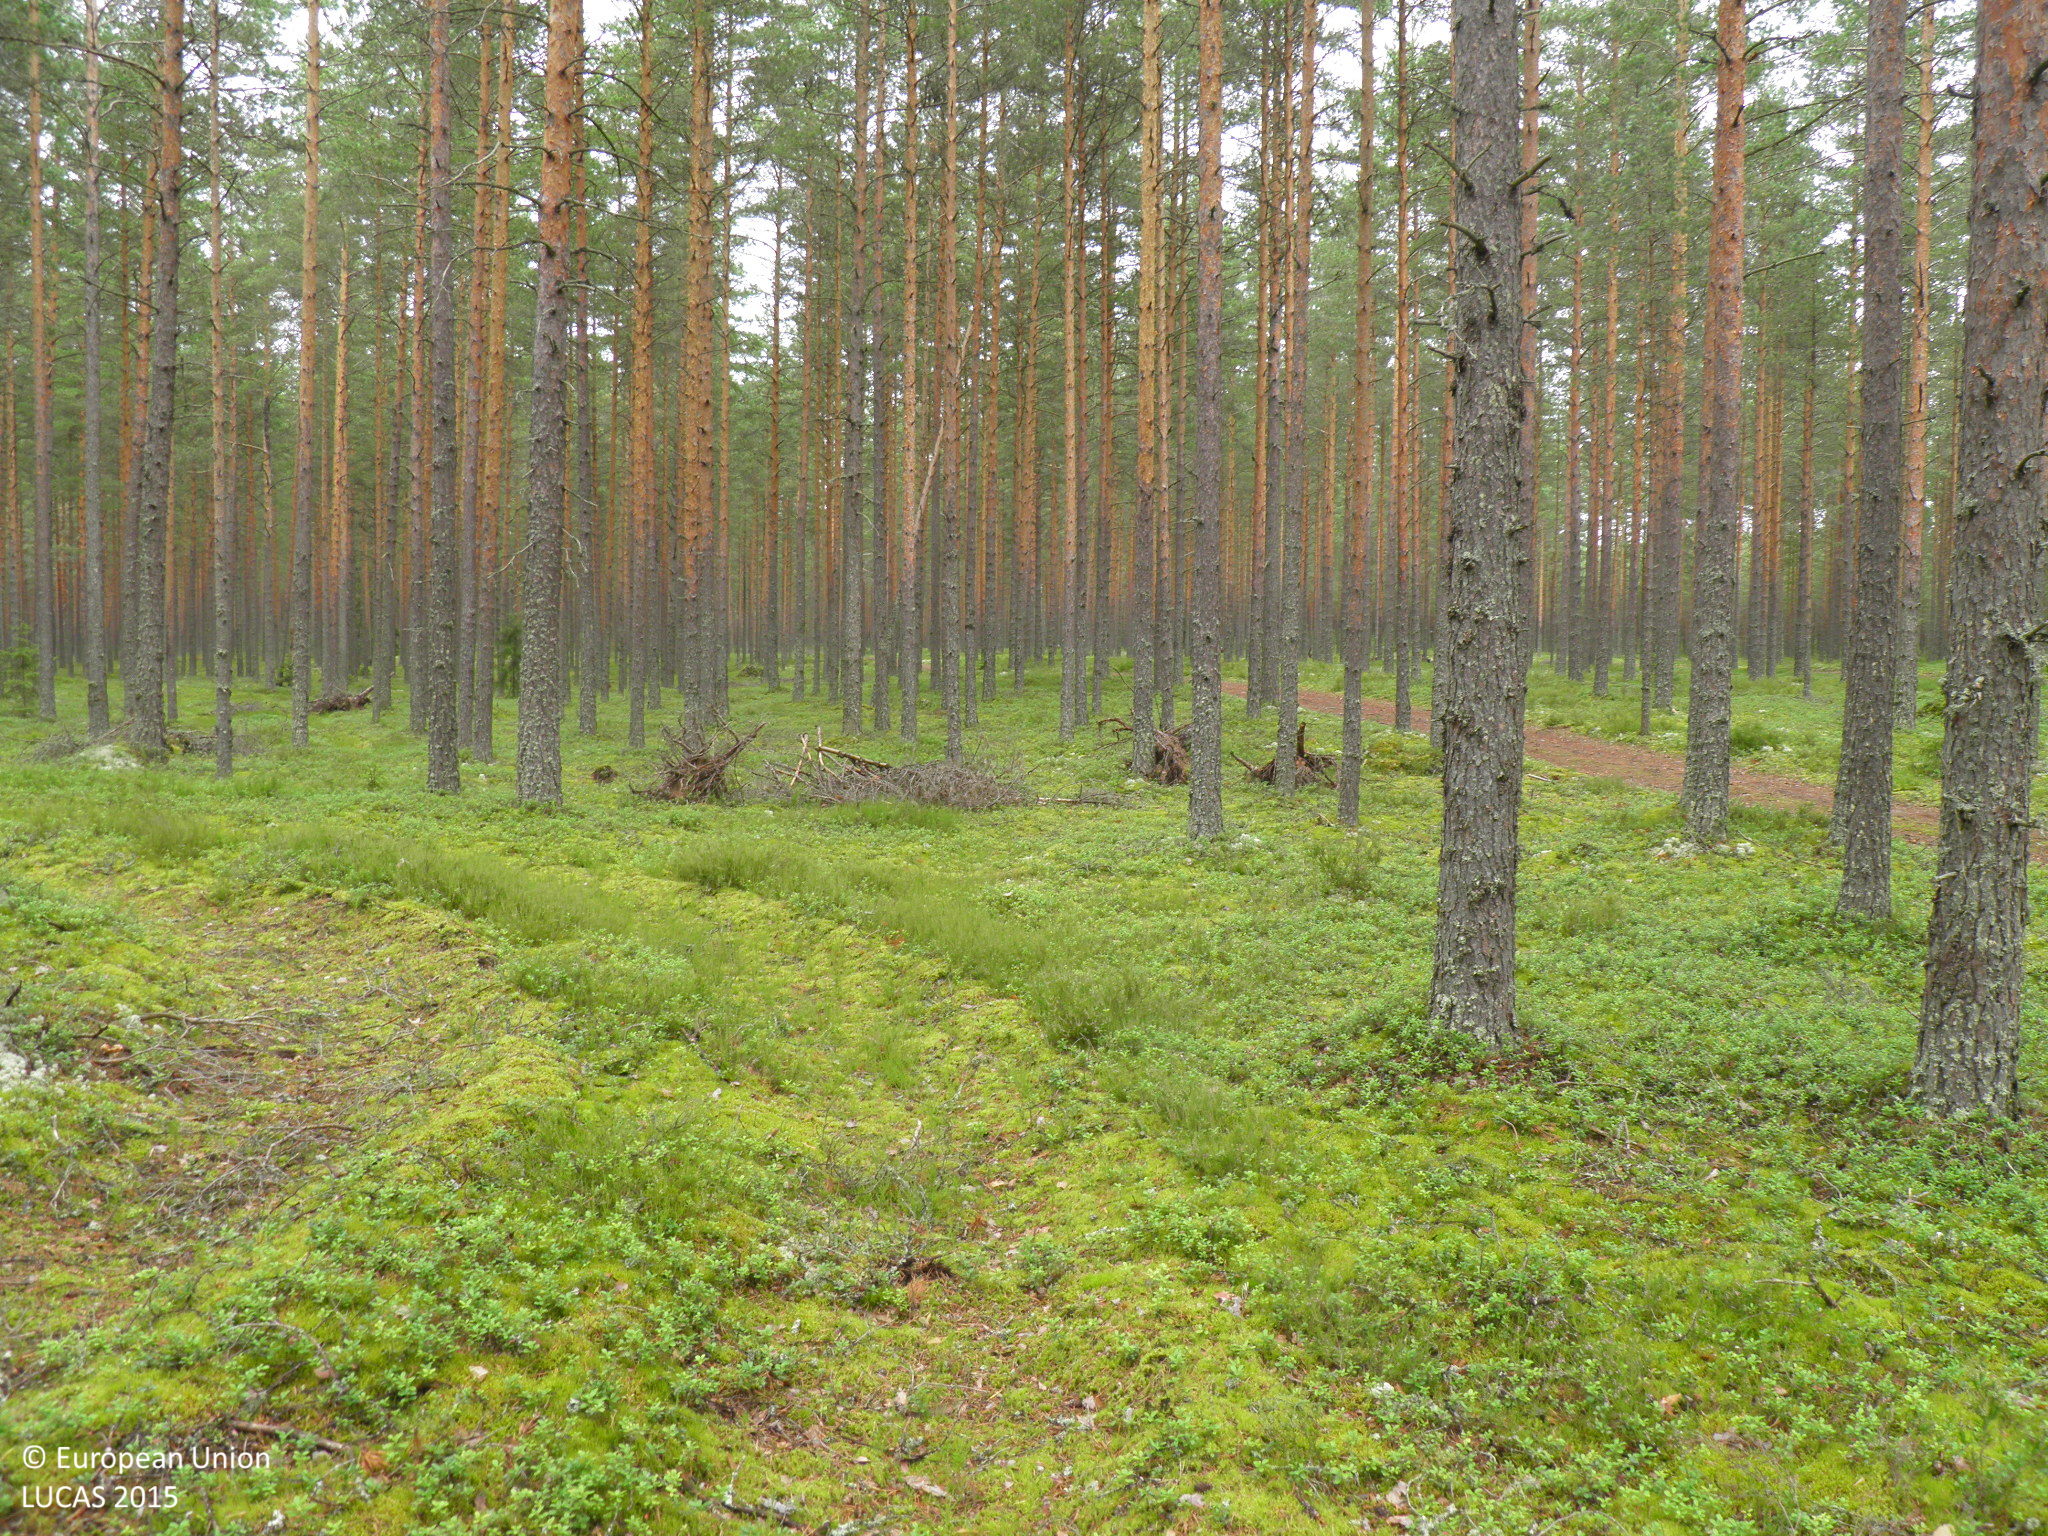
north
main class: Woodland
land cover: Pine dominated coniferous woodland
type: hemiboreal forest and nemoral coniferous forest and mixed broadleaved-coniferous forest
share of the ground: 50 - 75 %
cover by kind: coniferous forest trees 60 %, lichens and mosses 30 %, shrubs 10 %
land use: Forestry
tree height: > 5 m
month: July
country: FI
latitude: 60.8805
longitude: 22.7269
